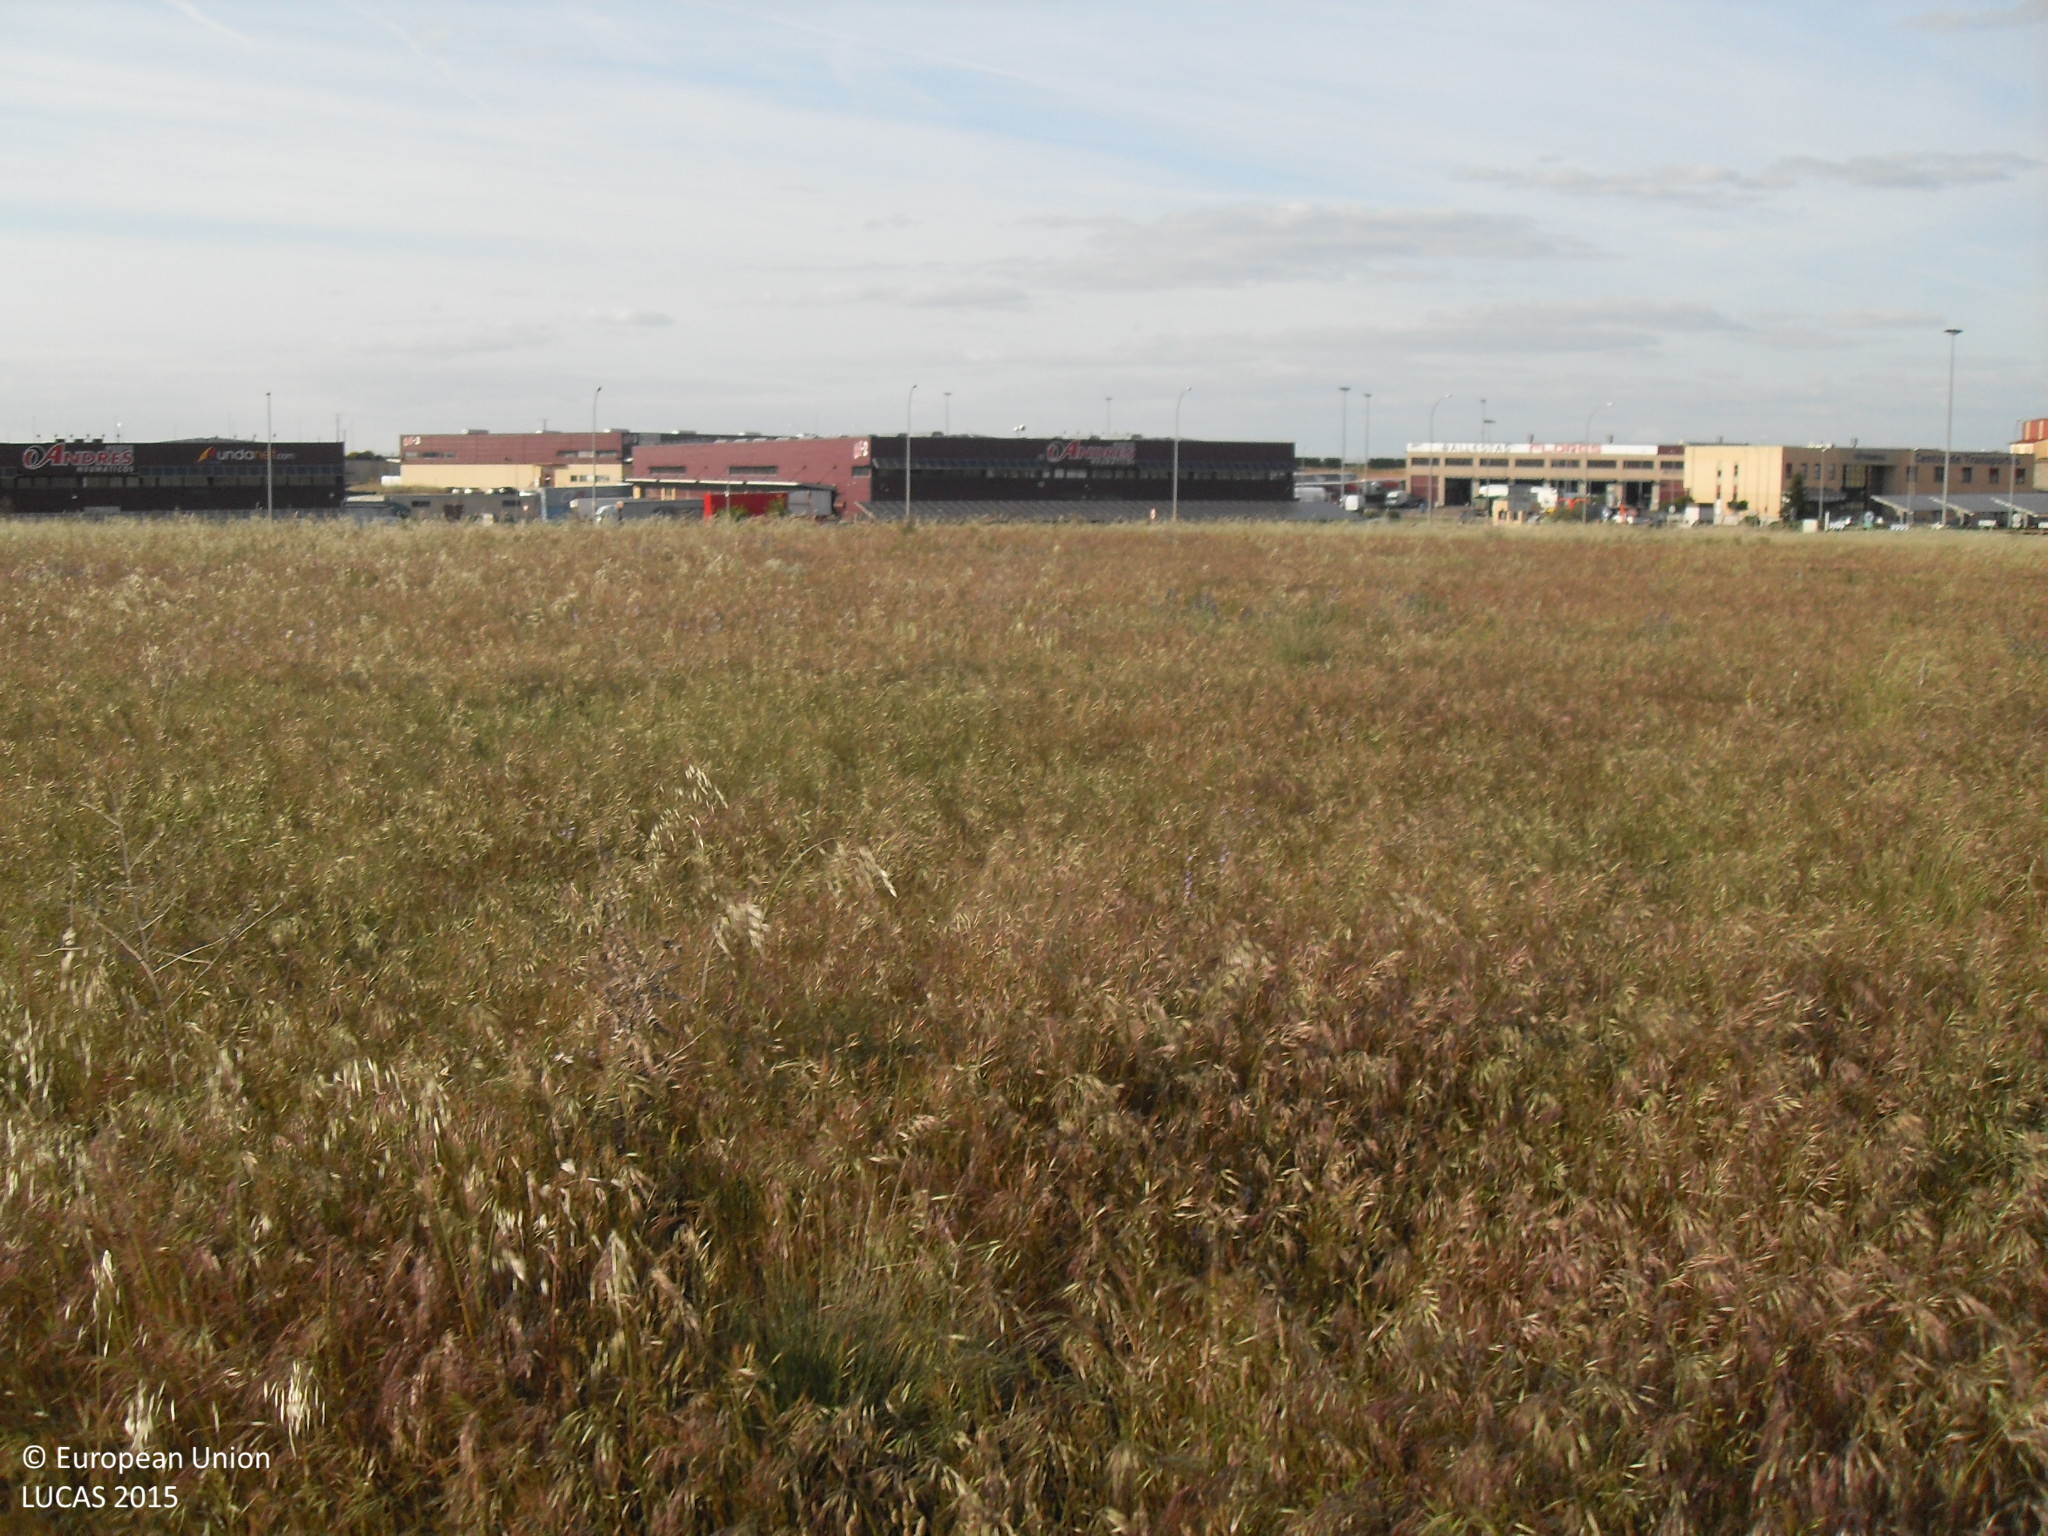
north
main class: Grassland
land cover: Grassland without tree/shrub cover
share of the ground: > 75 %
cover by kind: herbaceous plants 100 %
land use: Agriculture (excluding fallow land and kitchen gardens)
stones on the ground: 10 - 25 %
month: May
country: ES
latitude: 40.9574
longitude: -5.7254
